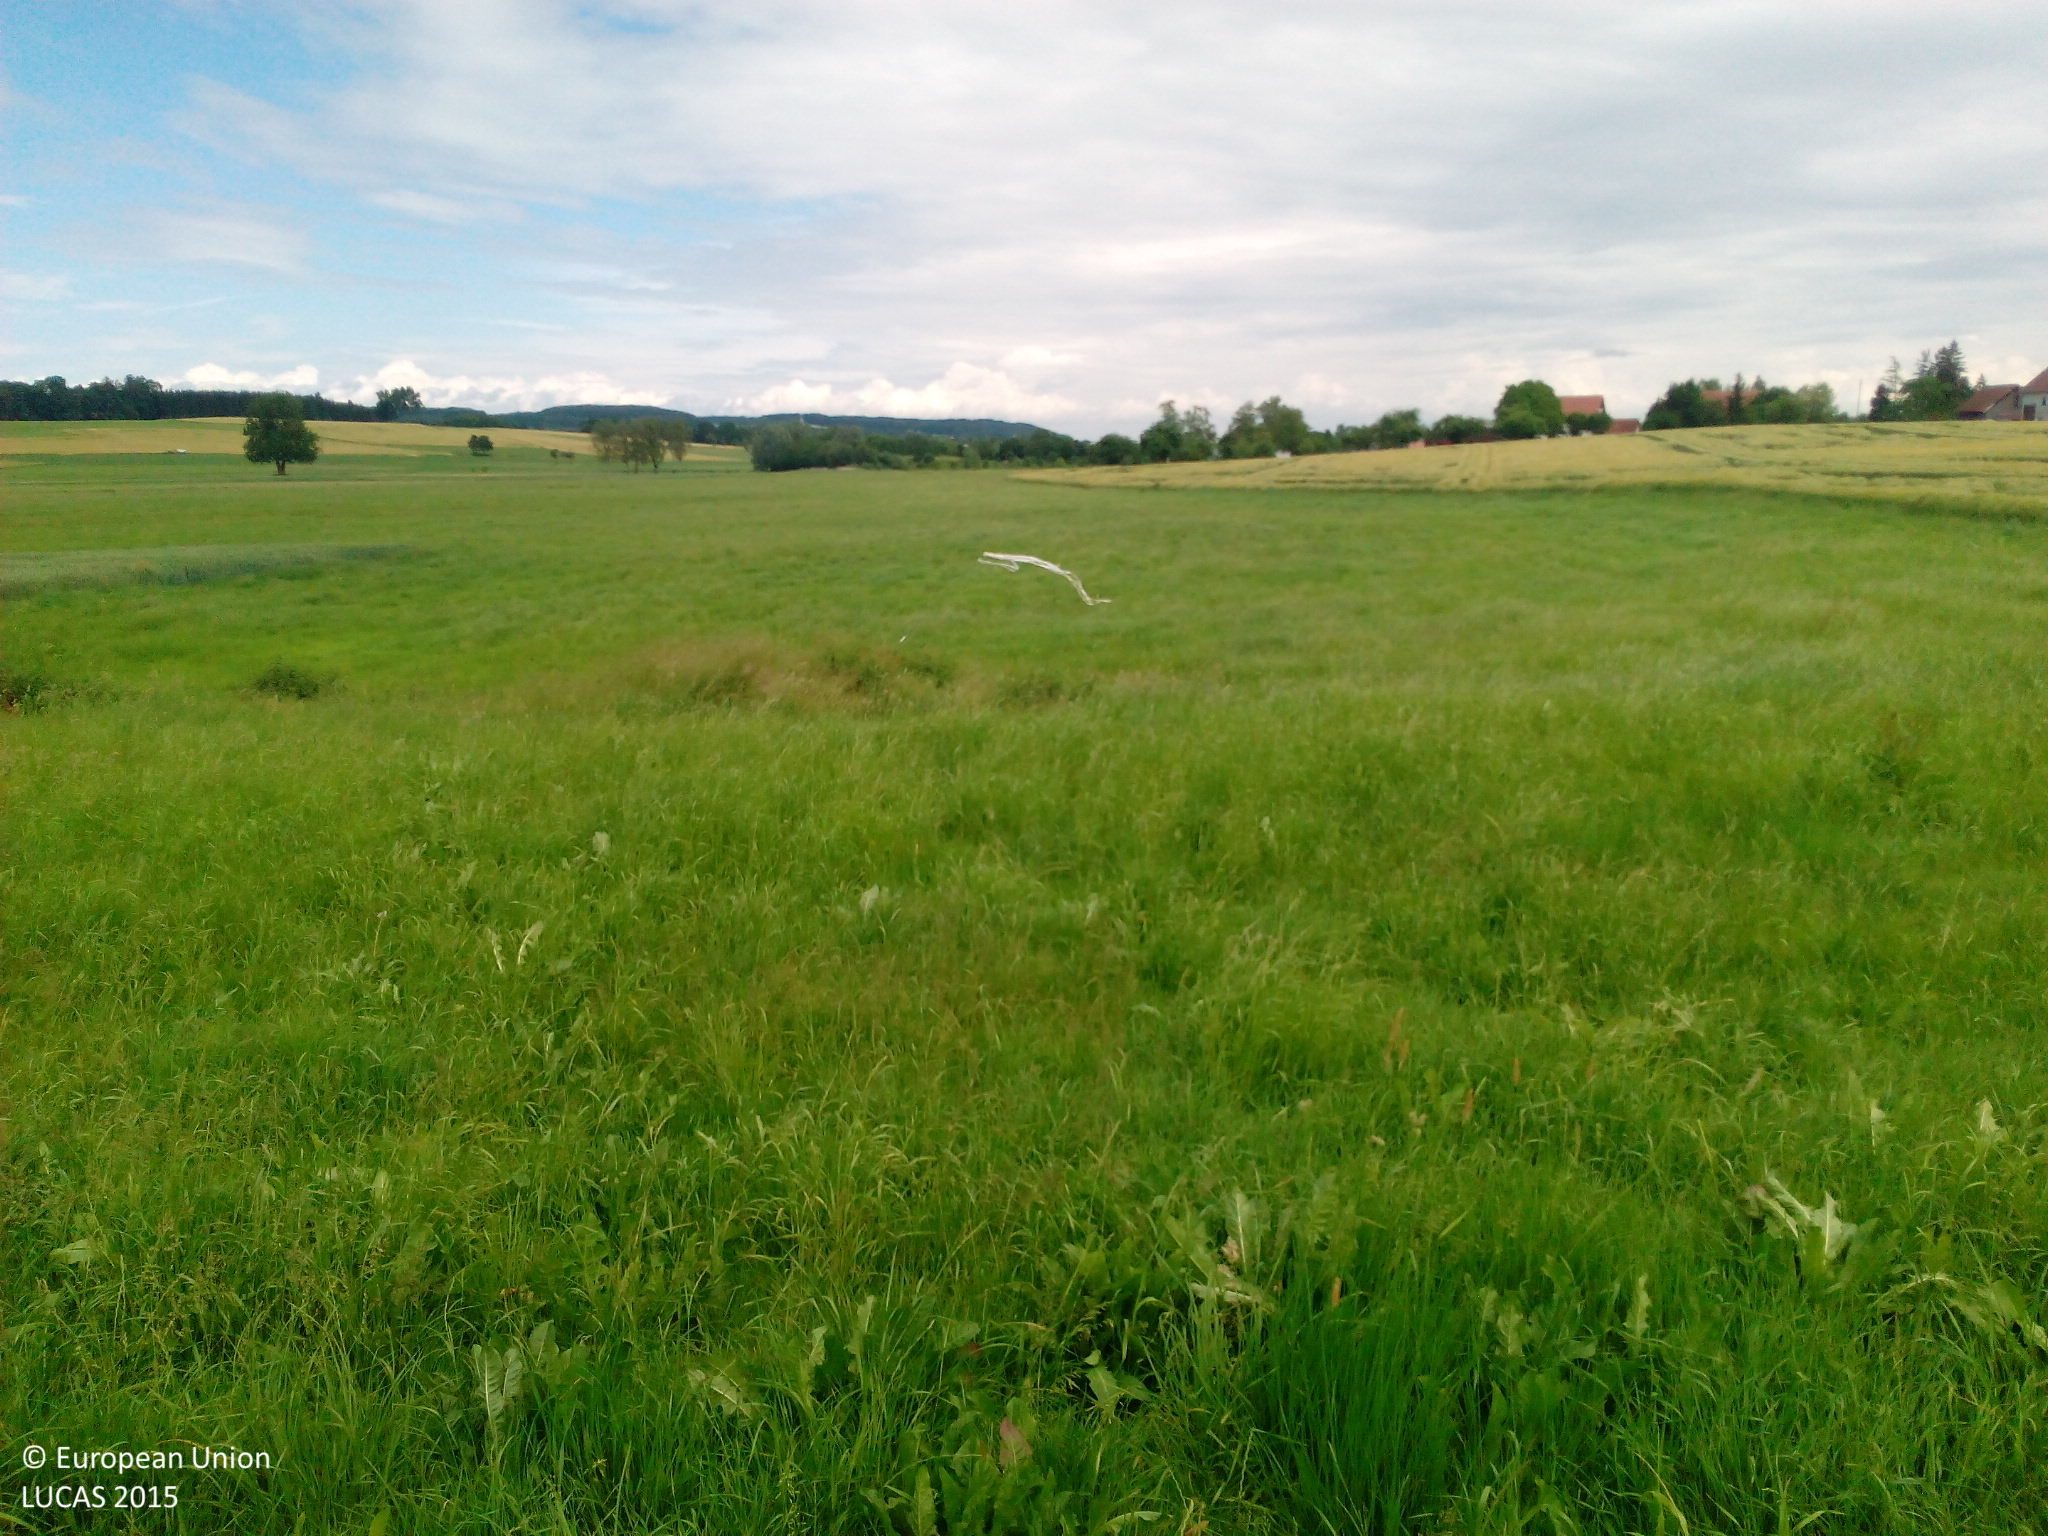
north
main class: Cropland
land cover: Common wheat
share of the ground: > 75 %
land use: Agriculture (excluding fallow land and kitchen gardens)
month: June
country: DE
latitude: 47.9170
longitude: 9.6390
